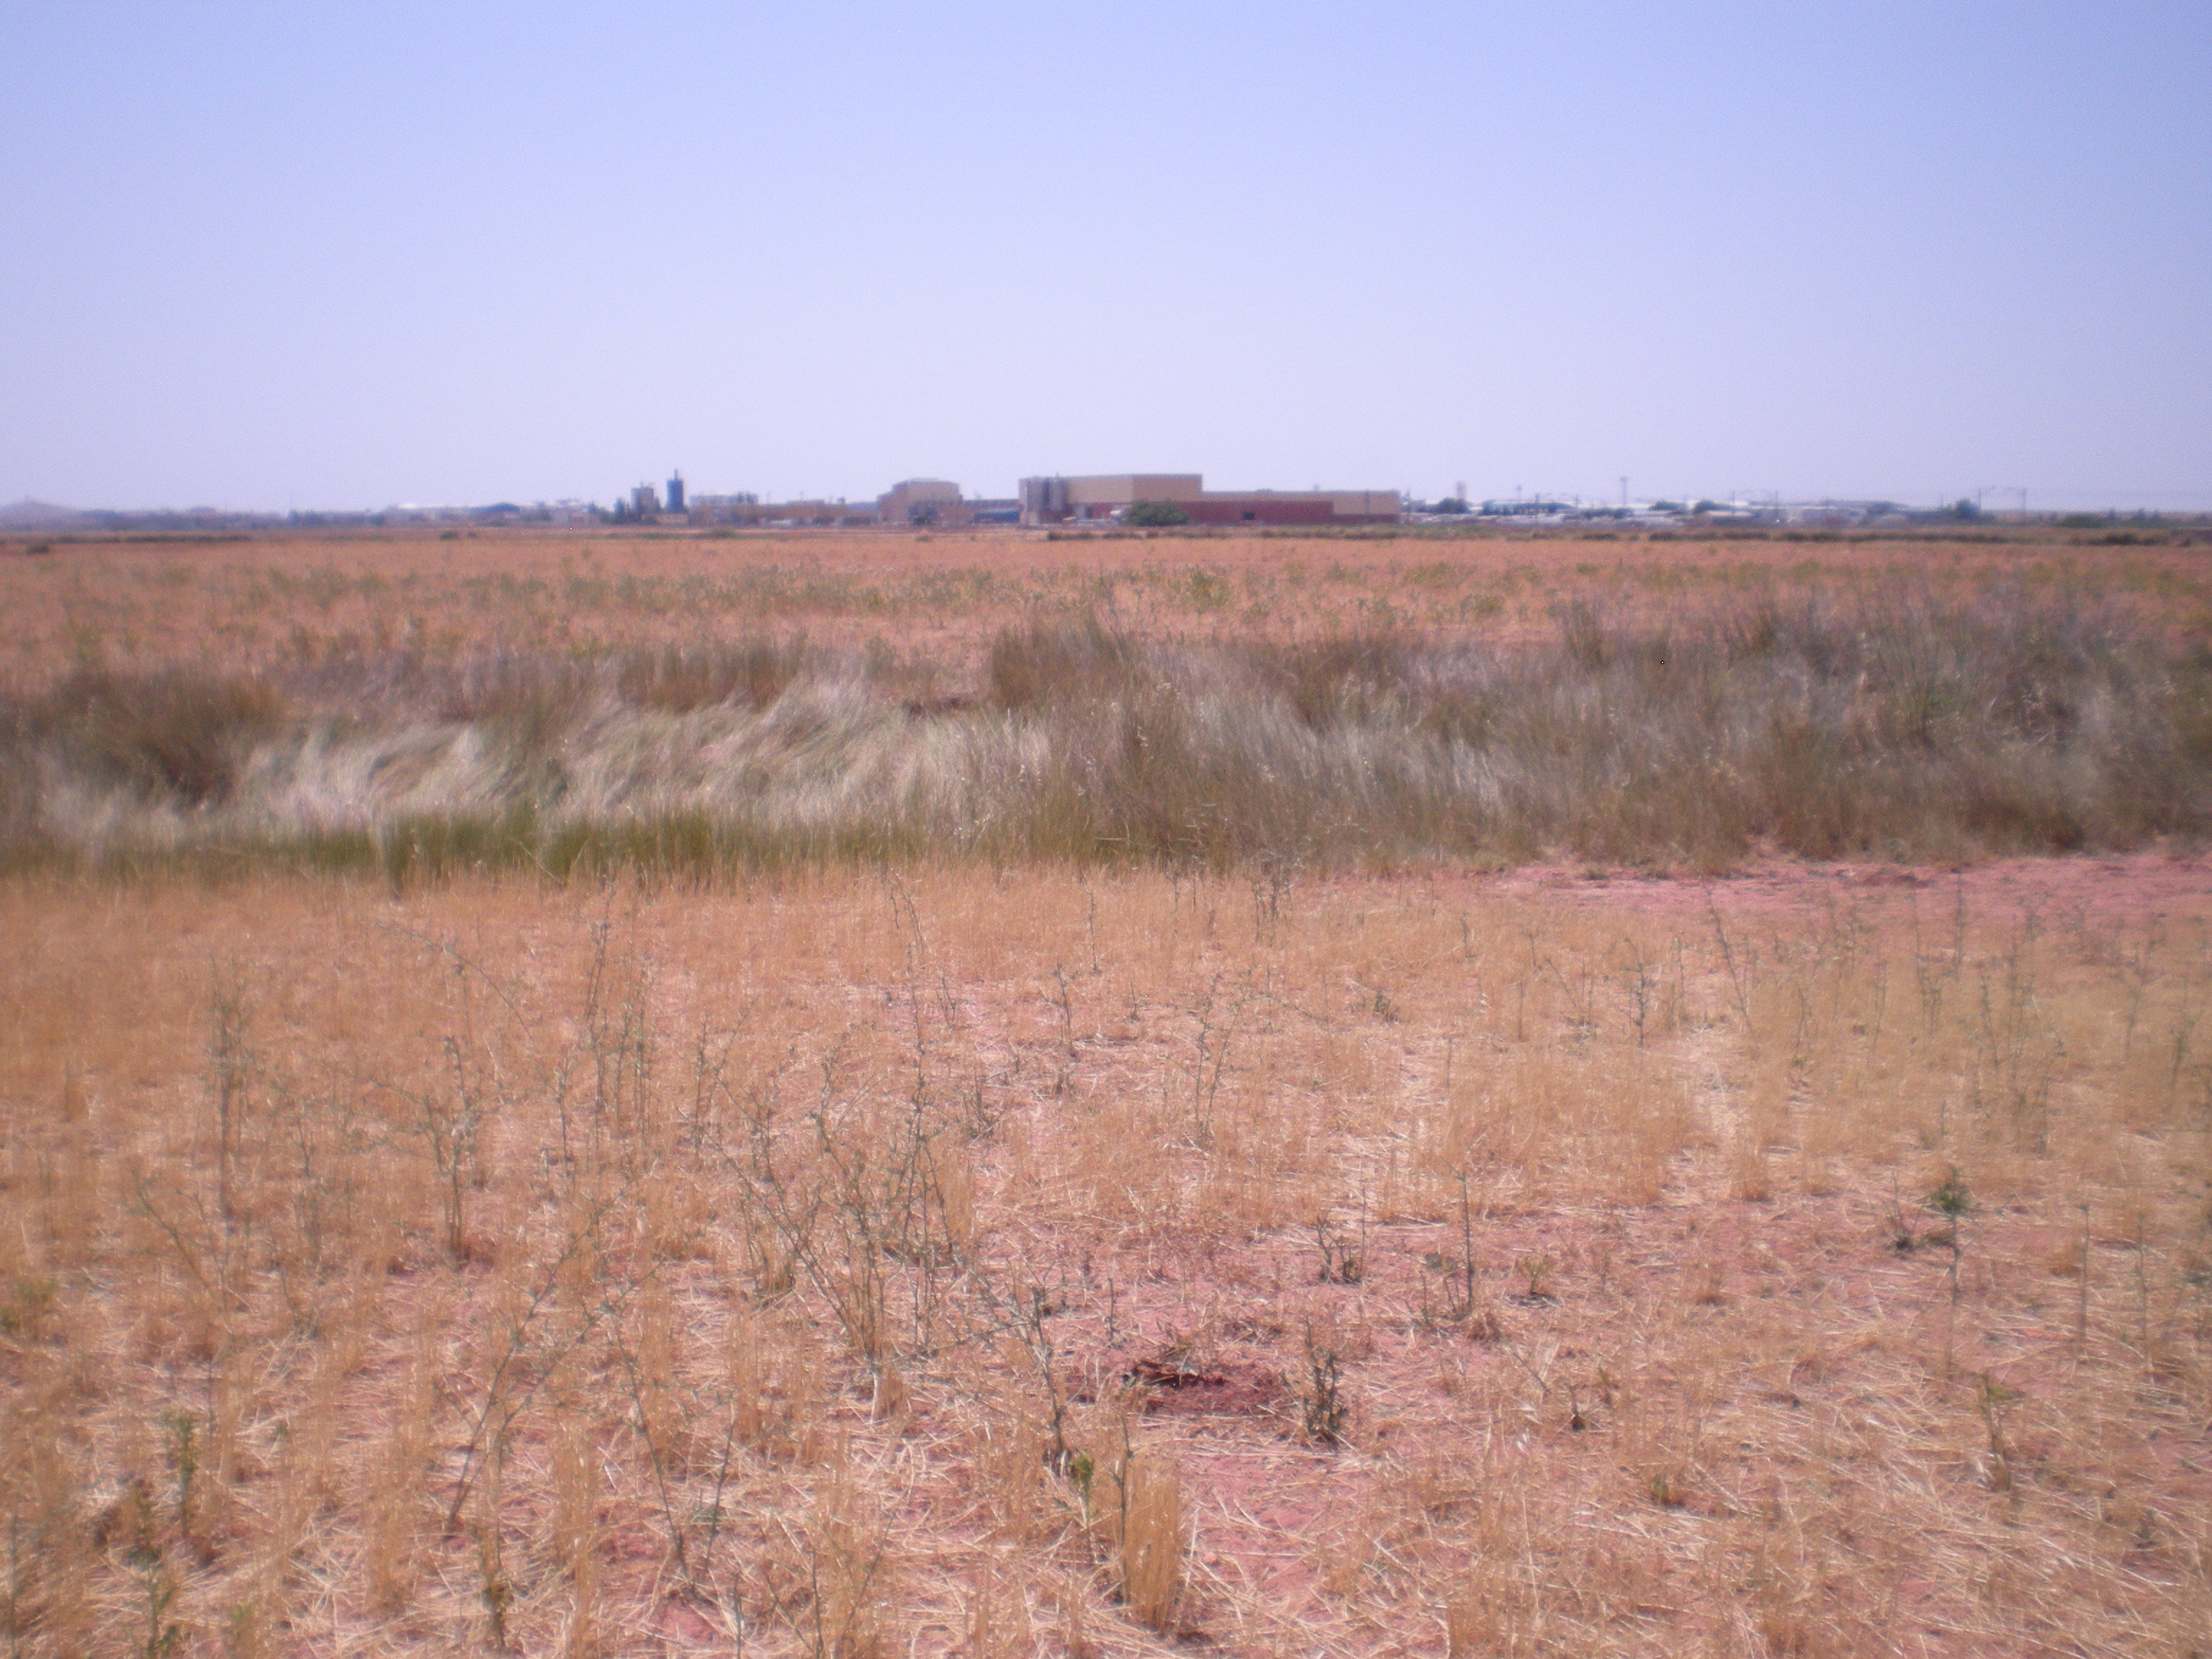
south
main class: Cropland
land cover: Barley
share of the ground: < 10 %
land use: Agriculture (excluding fallow land and kitchen gardens)
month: July
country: ES
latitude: 39.4225
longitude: -3.2259
